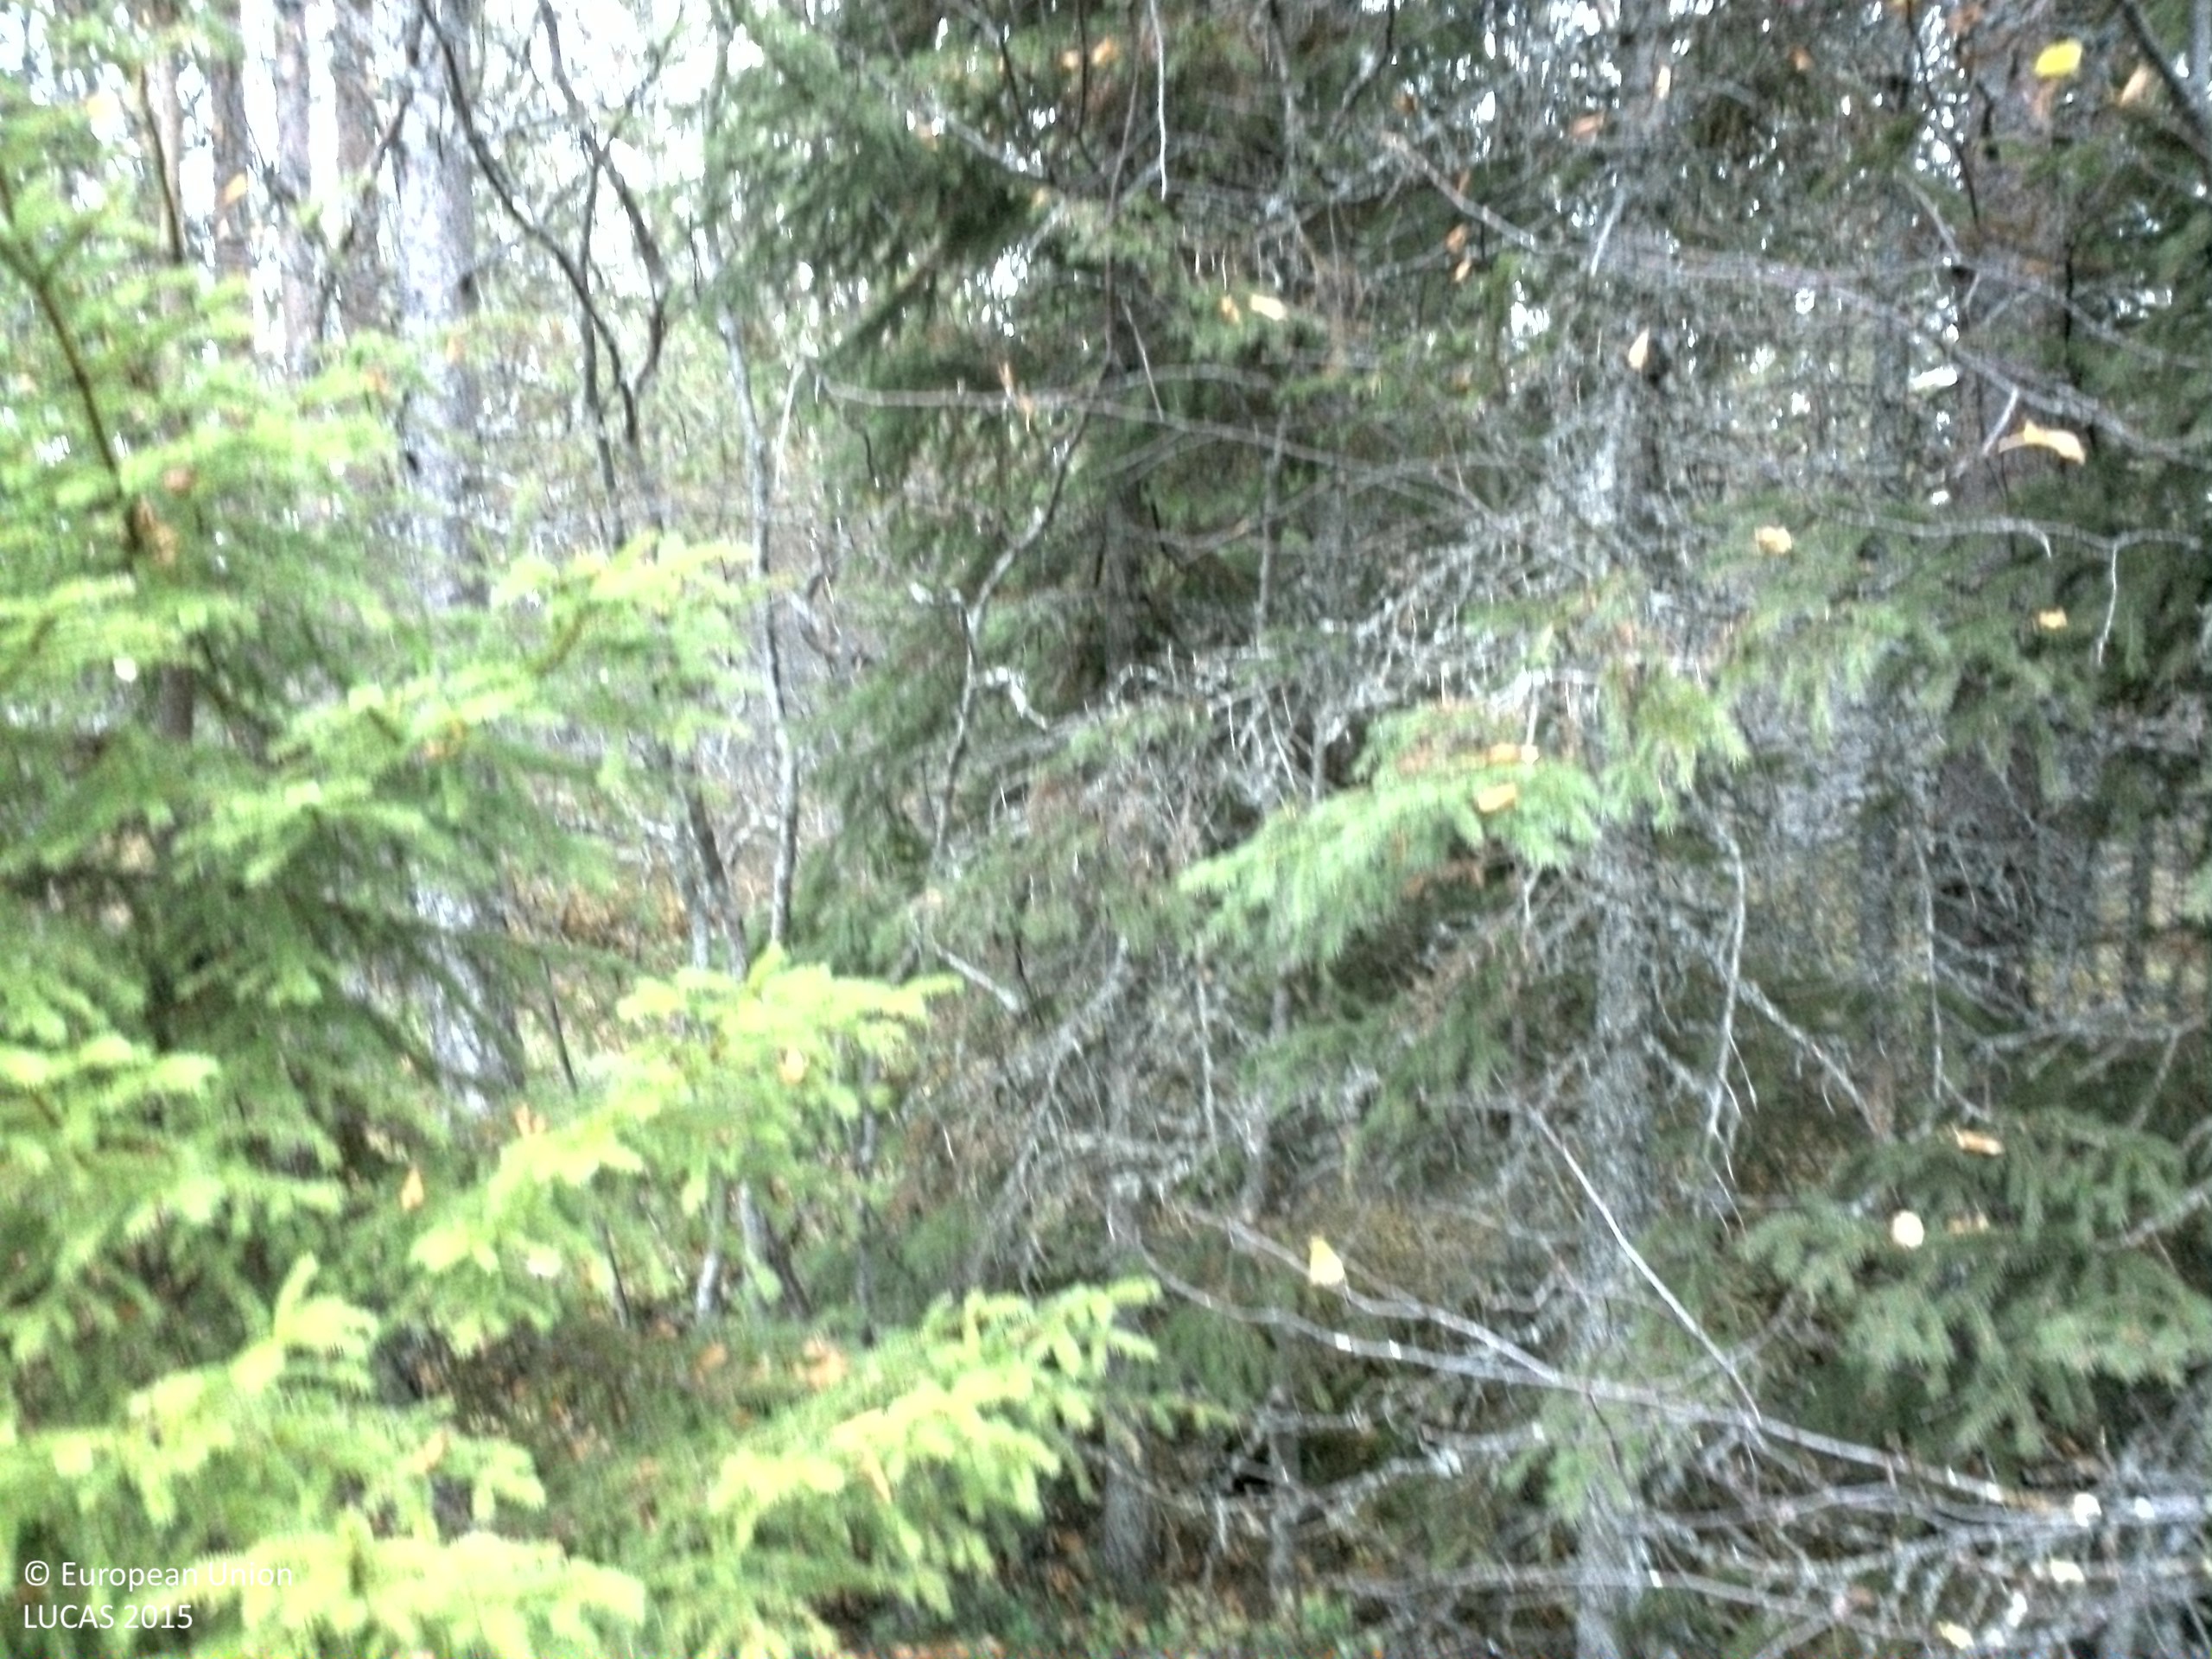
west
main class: Woodland
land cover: Spruce dominated mixed woodland
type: boreal forest
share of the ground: 25 - 50 %
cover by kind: coniferous forest trees 30 %, shrubs 30 %, consolidated bare surface 25 %, broadleaved forest trees 15 %
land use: Forestry
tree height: > 5 m
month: October
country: SE
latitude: 61.3246
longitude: 14.2642
